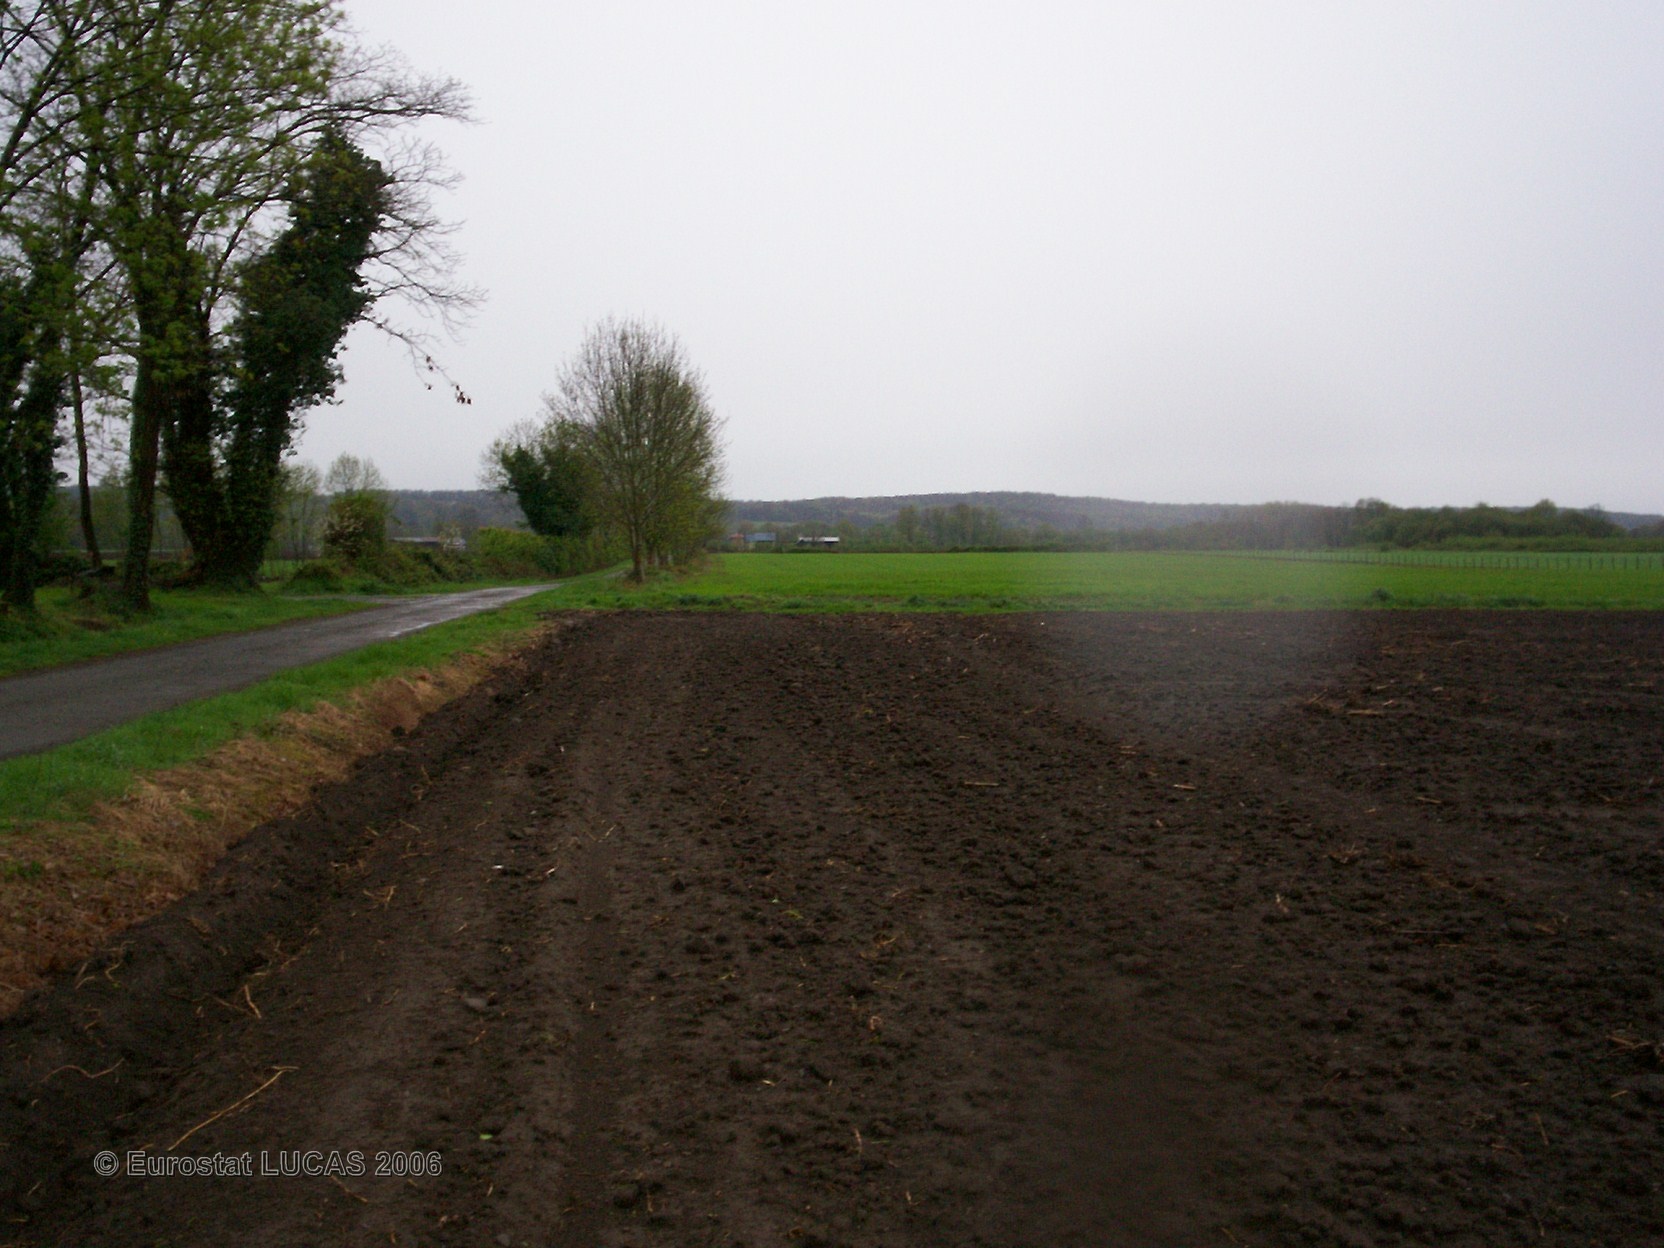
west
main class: Cropland
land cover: Maize
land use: Agriculture (excluding fallow land and kitchen gardens)
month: June
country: FR
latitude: 43.1992
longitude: -0.1326
